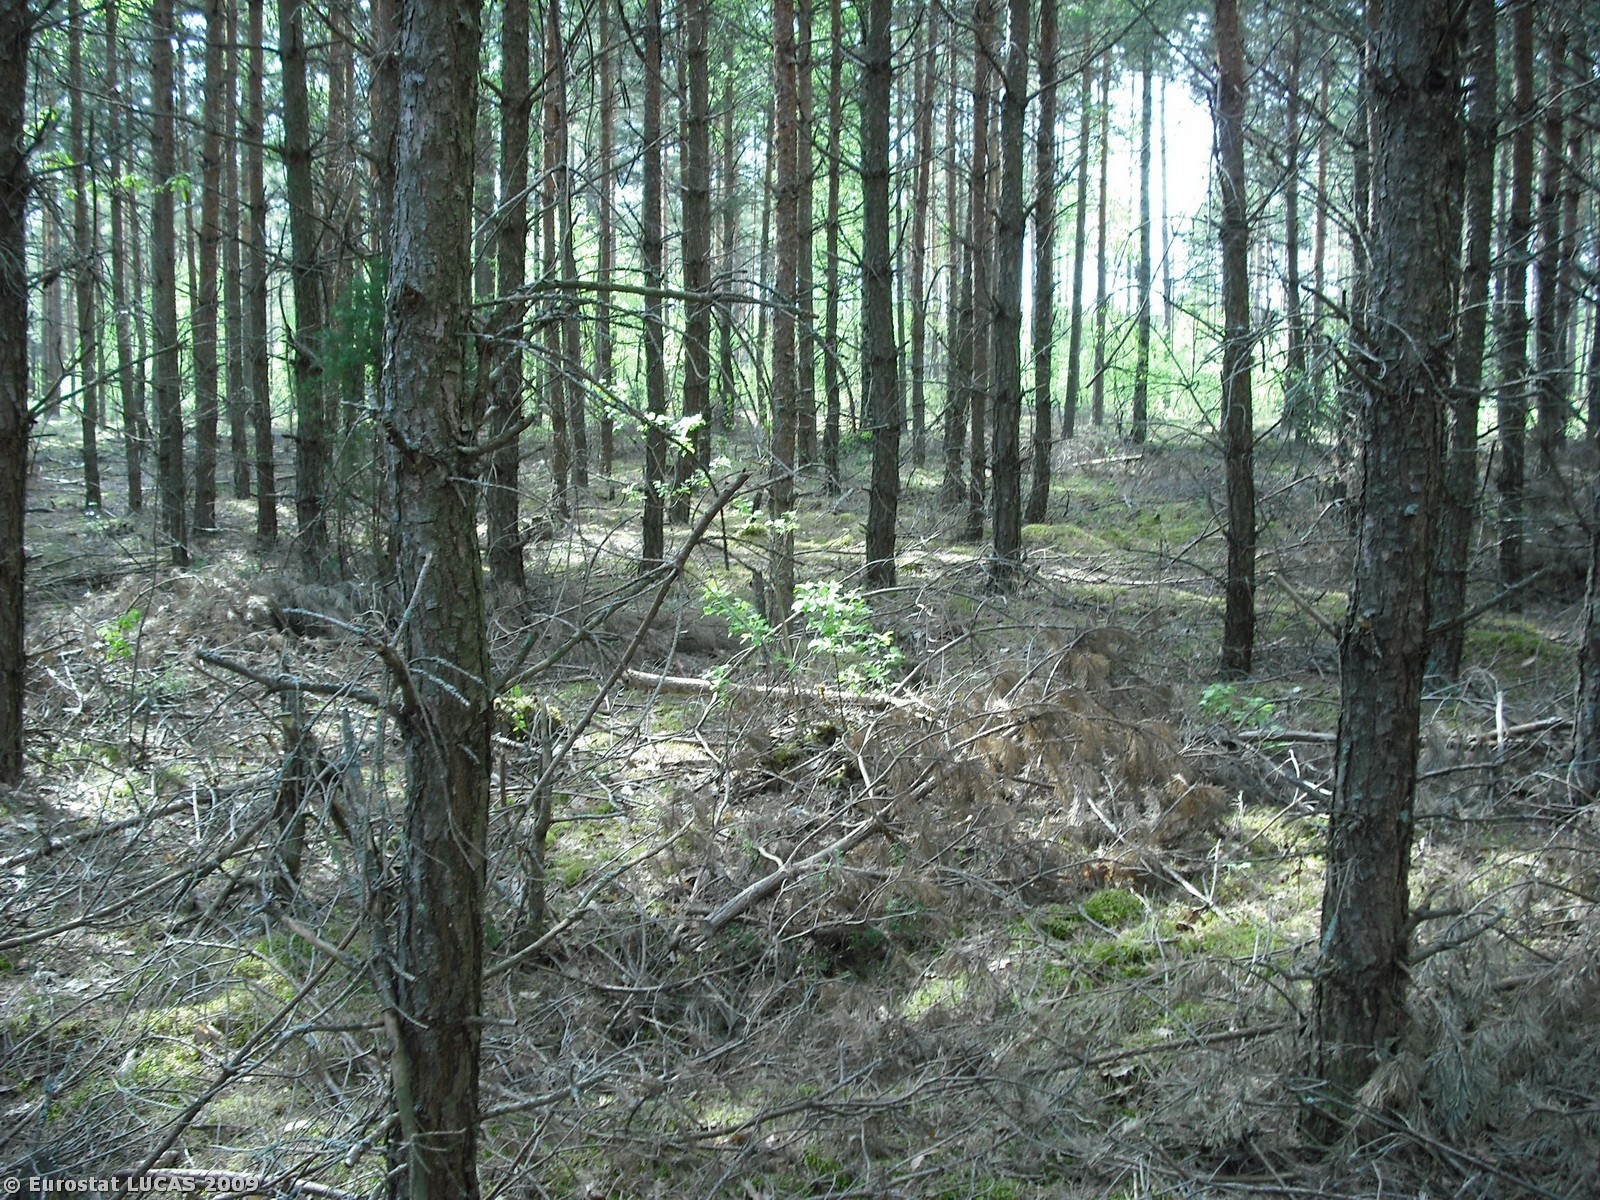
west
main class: Woodland
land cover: Coniferous woodland
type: hemiboreal forest and nemoral coniferous forest and mixed broadleaved-coniferous forest
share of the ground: > 75 %
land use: Forestry
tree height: > 5 m
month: May
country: PL
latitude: 53.0687
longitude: 23.5923
